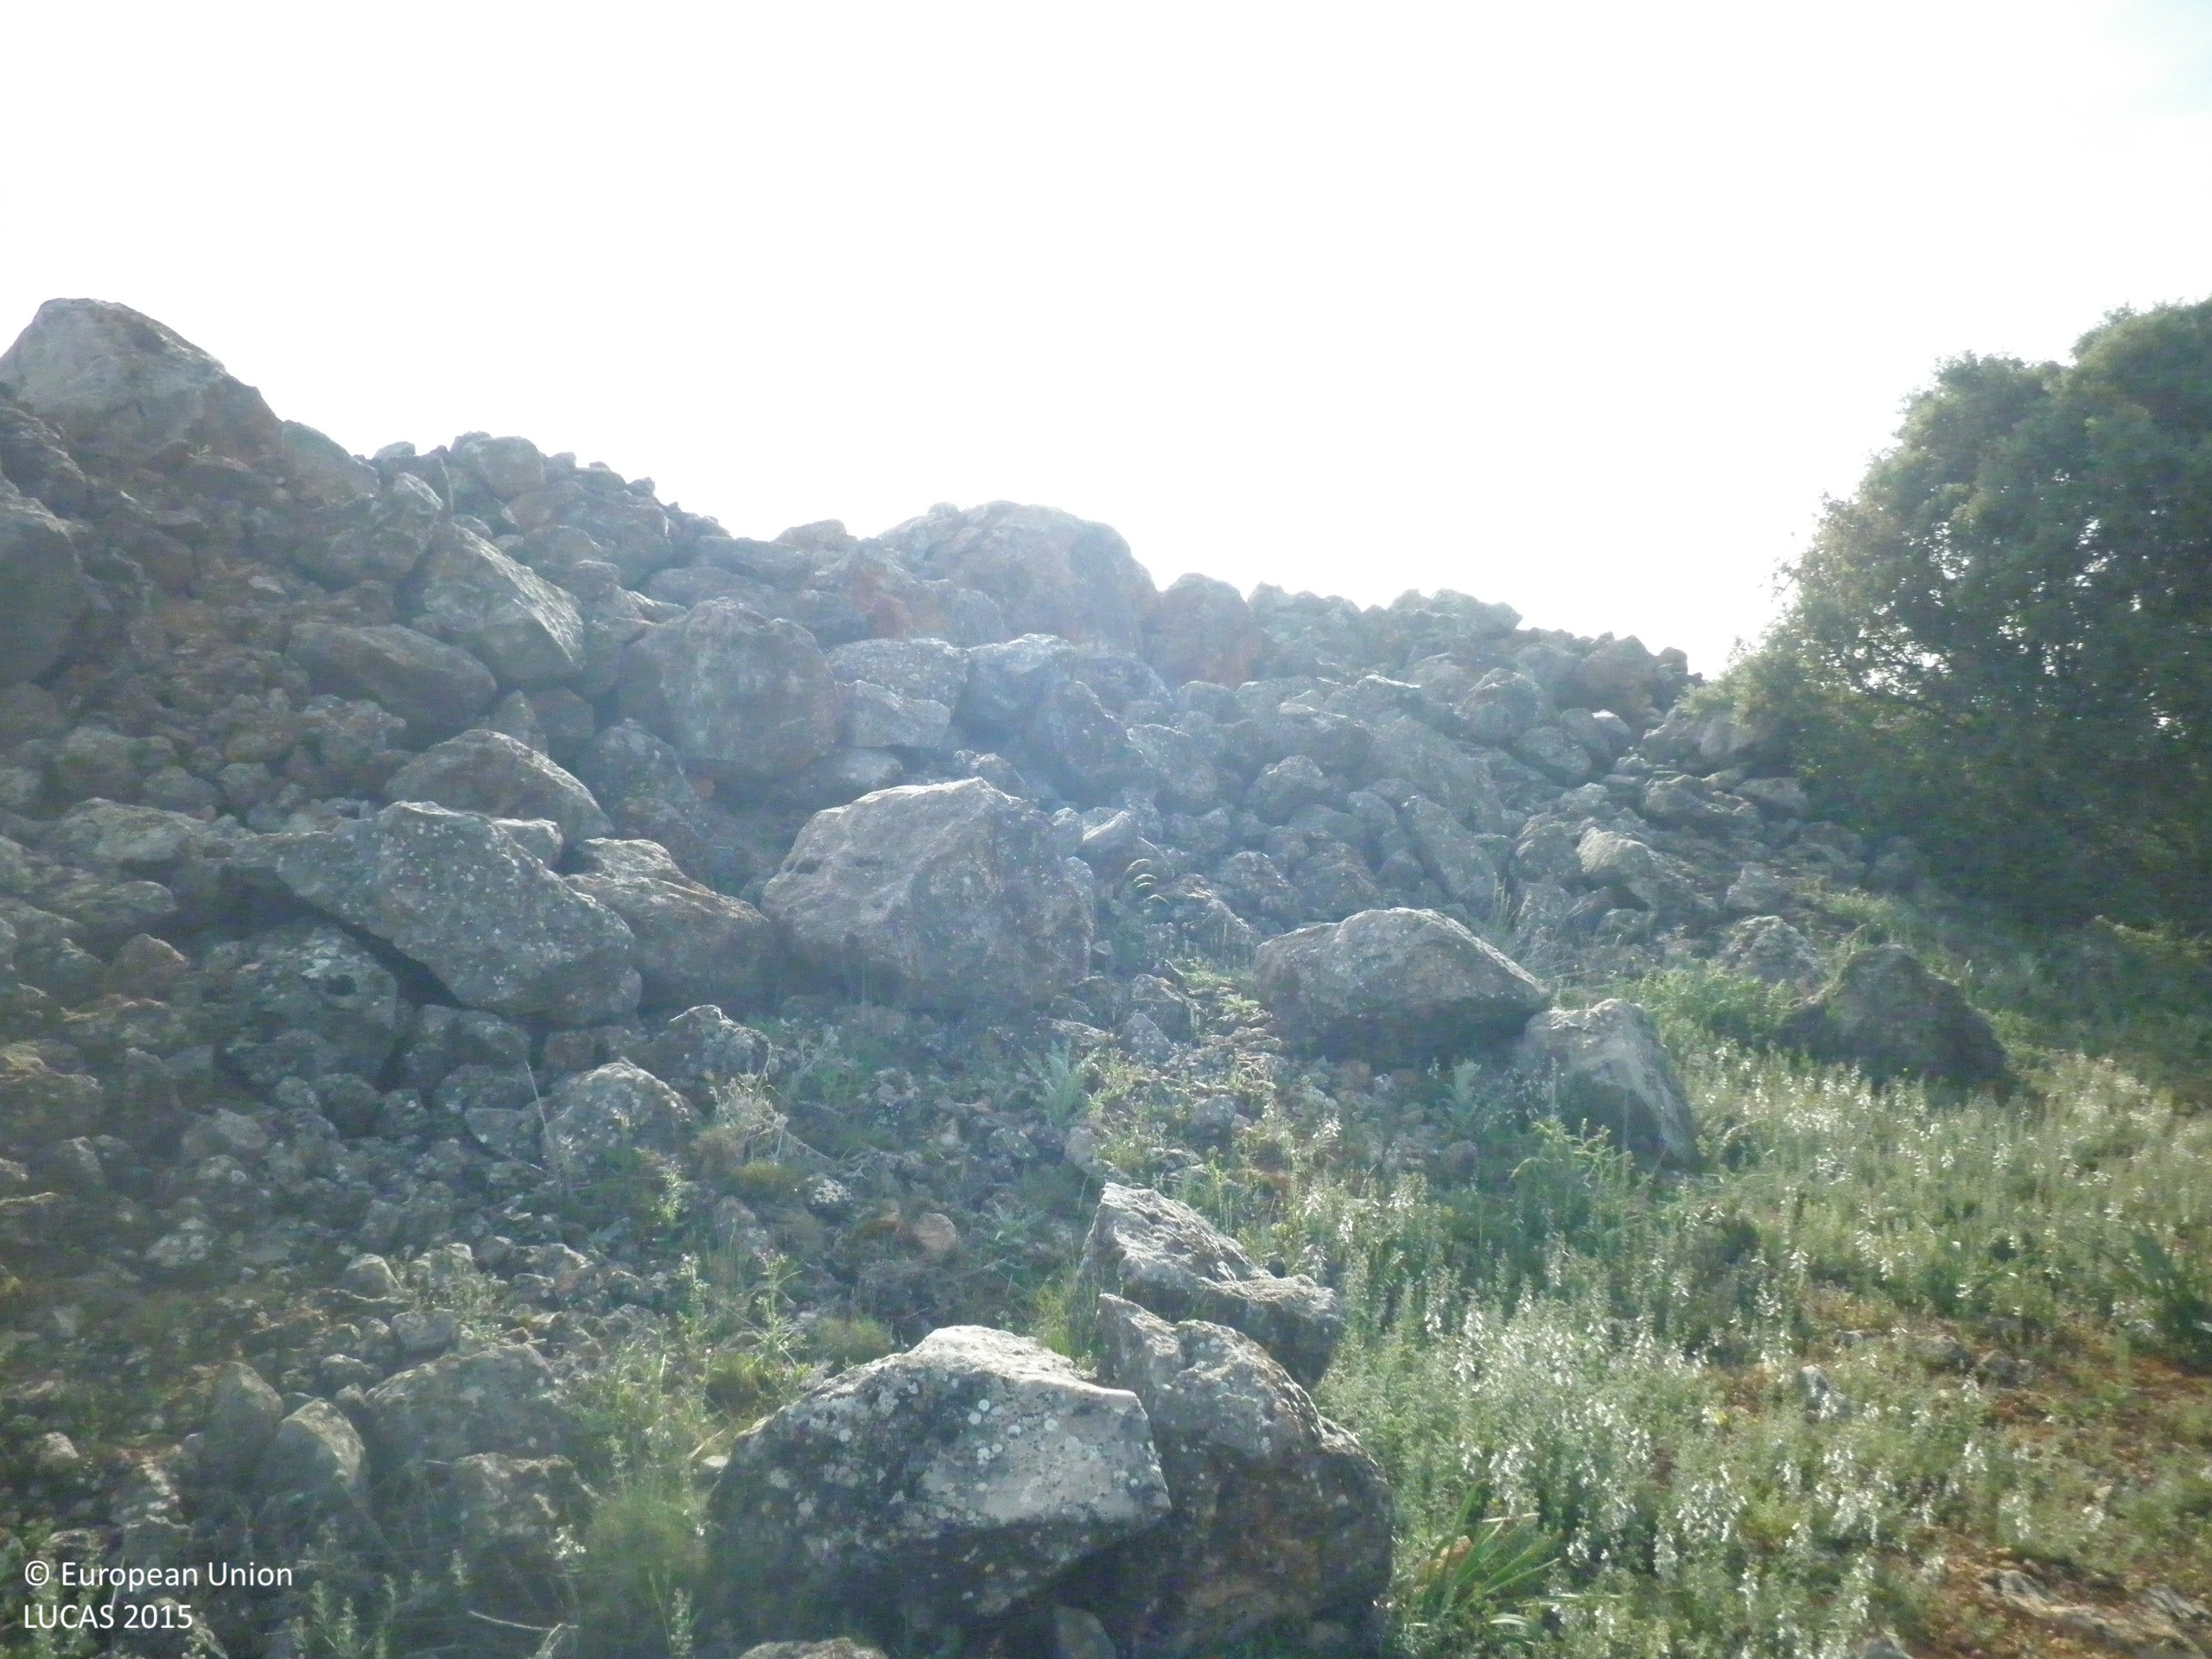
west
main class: Grassland
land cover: Grassland without tree/shrub cover
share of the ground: 25 - 50 %
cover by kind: herbaceous plants 45 %, consolidated bare surface 25 %, unconsolidated bare surface 25 %, shrubs 5 %
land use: Semi-natural and natural areas not in use
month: May
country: ES
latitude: 39.6268
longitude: -2.7968
